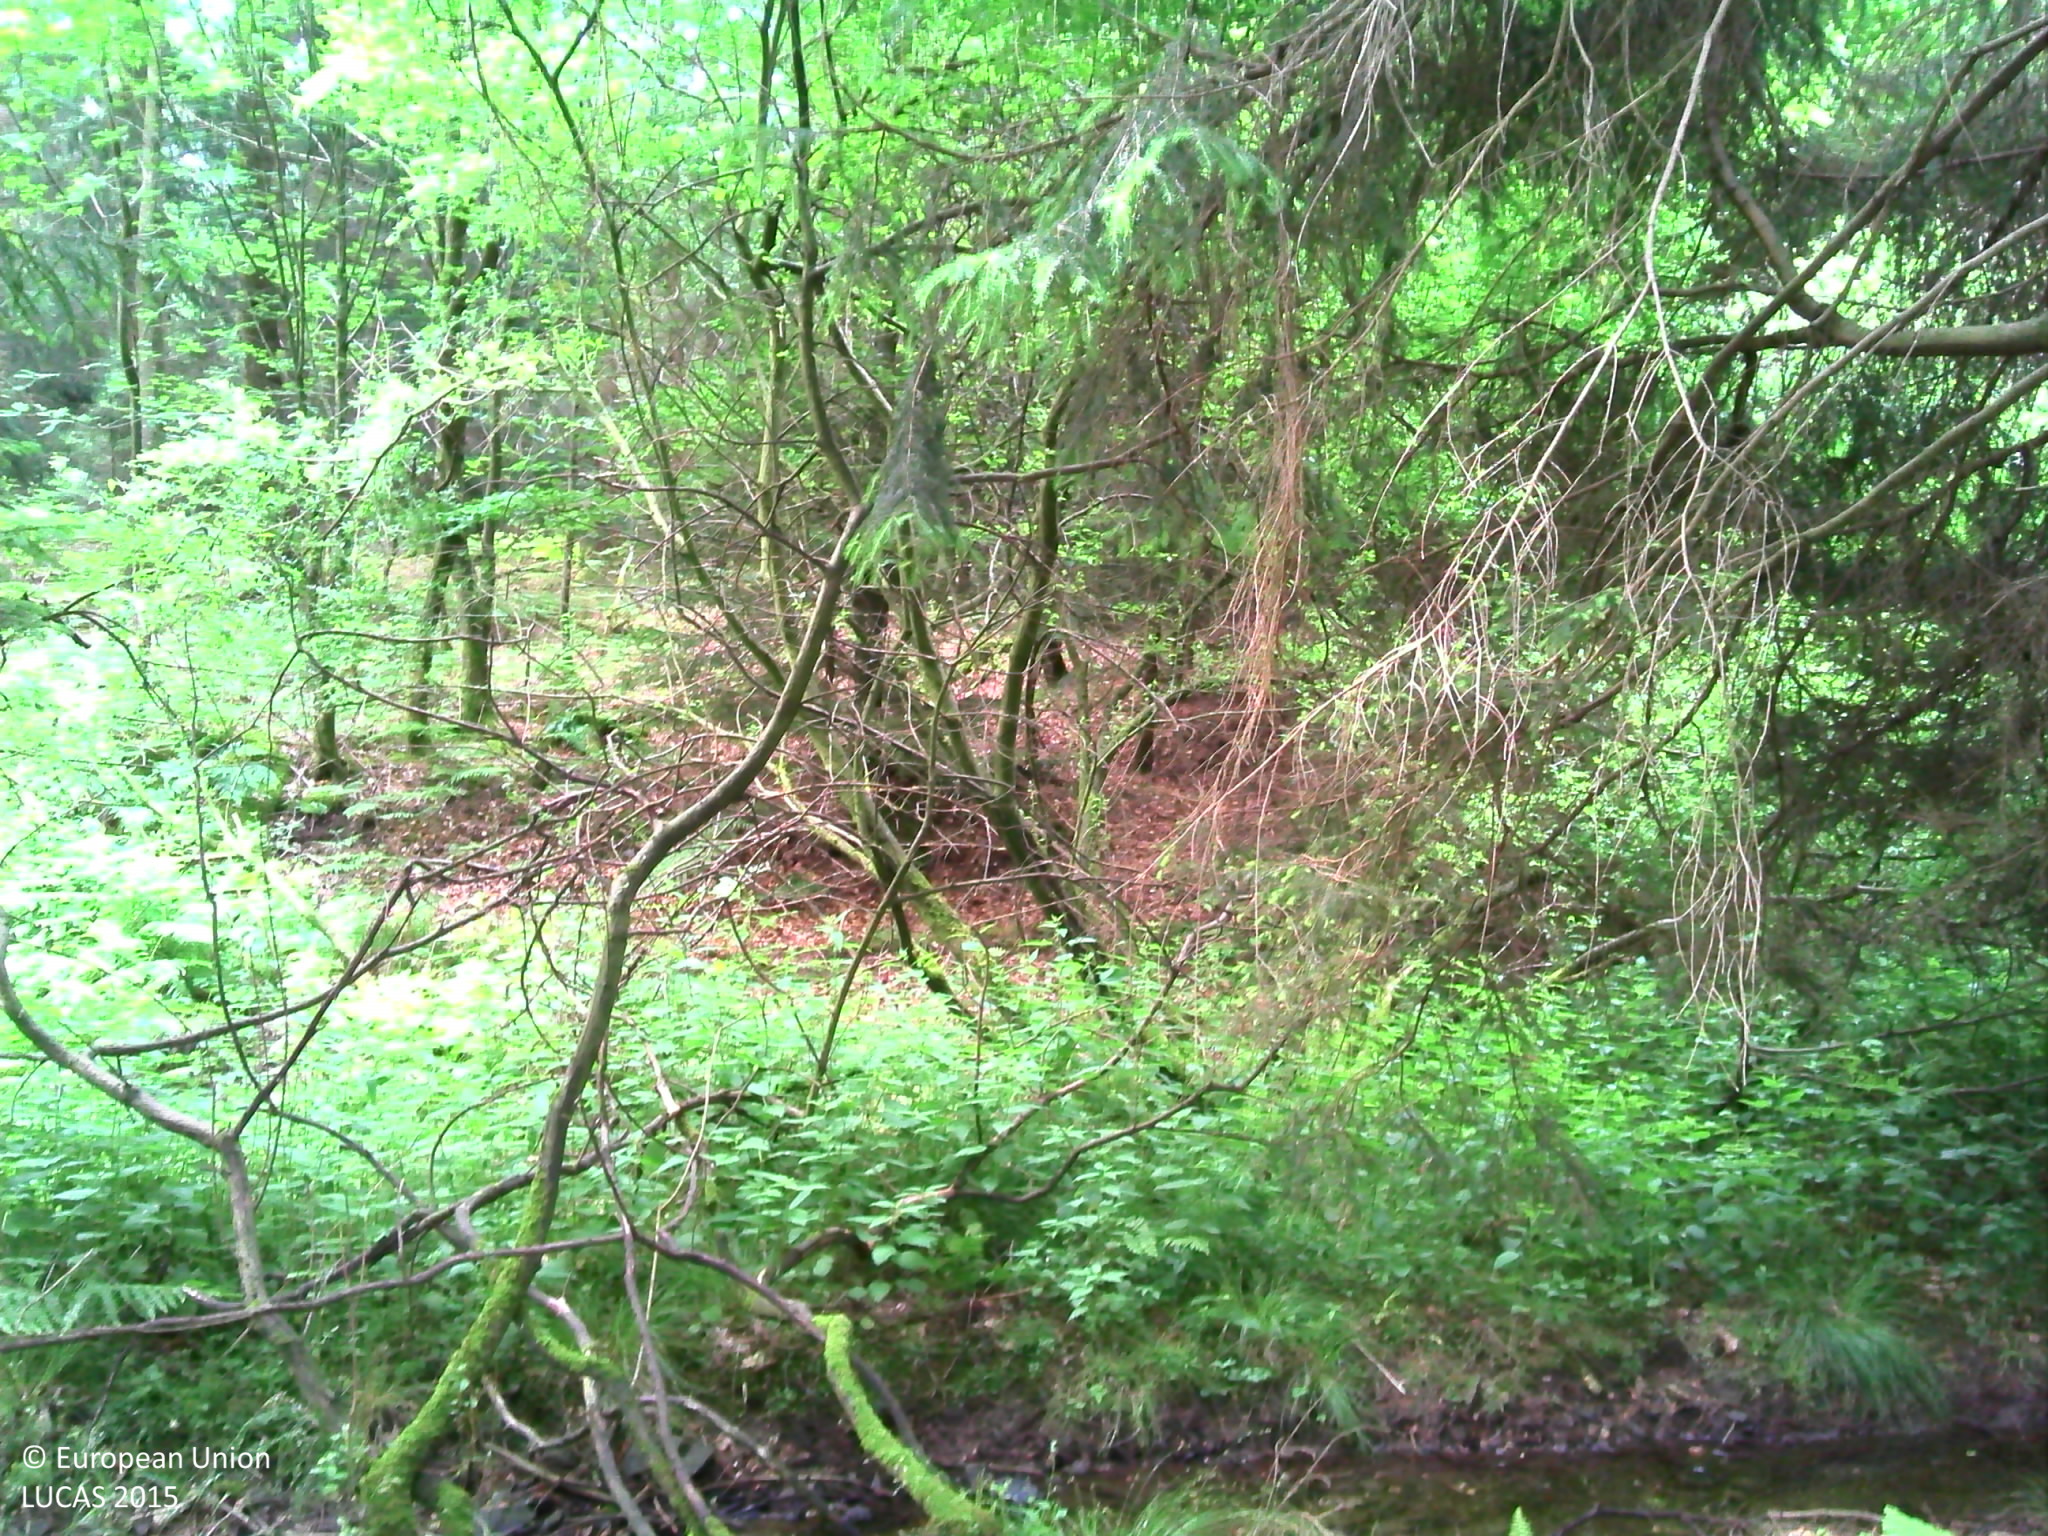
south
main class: Woodland
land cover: Spruce dominated coniferous woodland
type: alpine coniferous forest
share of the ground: > 75 %
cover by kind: coniferous forest trees 80 %, herbaceous plants 10 %, lichens and mosses 10 %
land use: Forestry
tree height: > 5 m
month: June
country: BE
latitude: 49.9254
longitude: 5.3037
